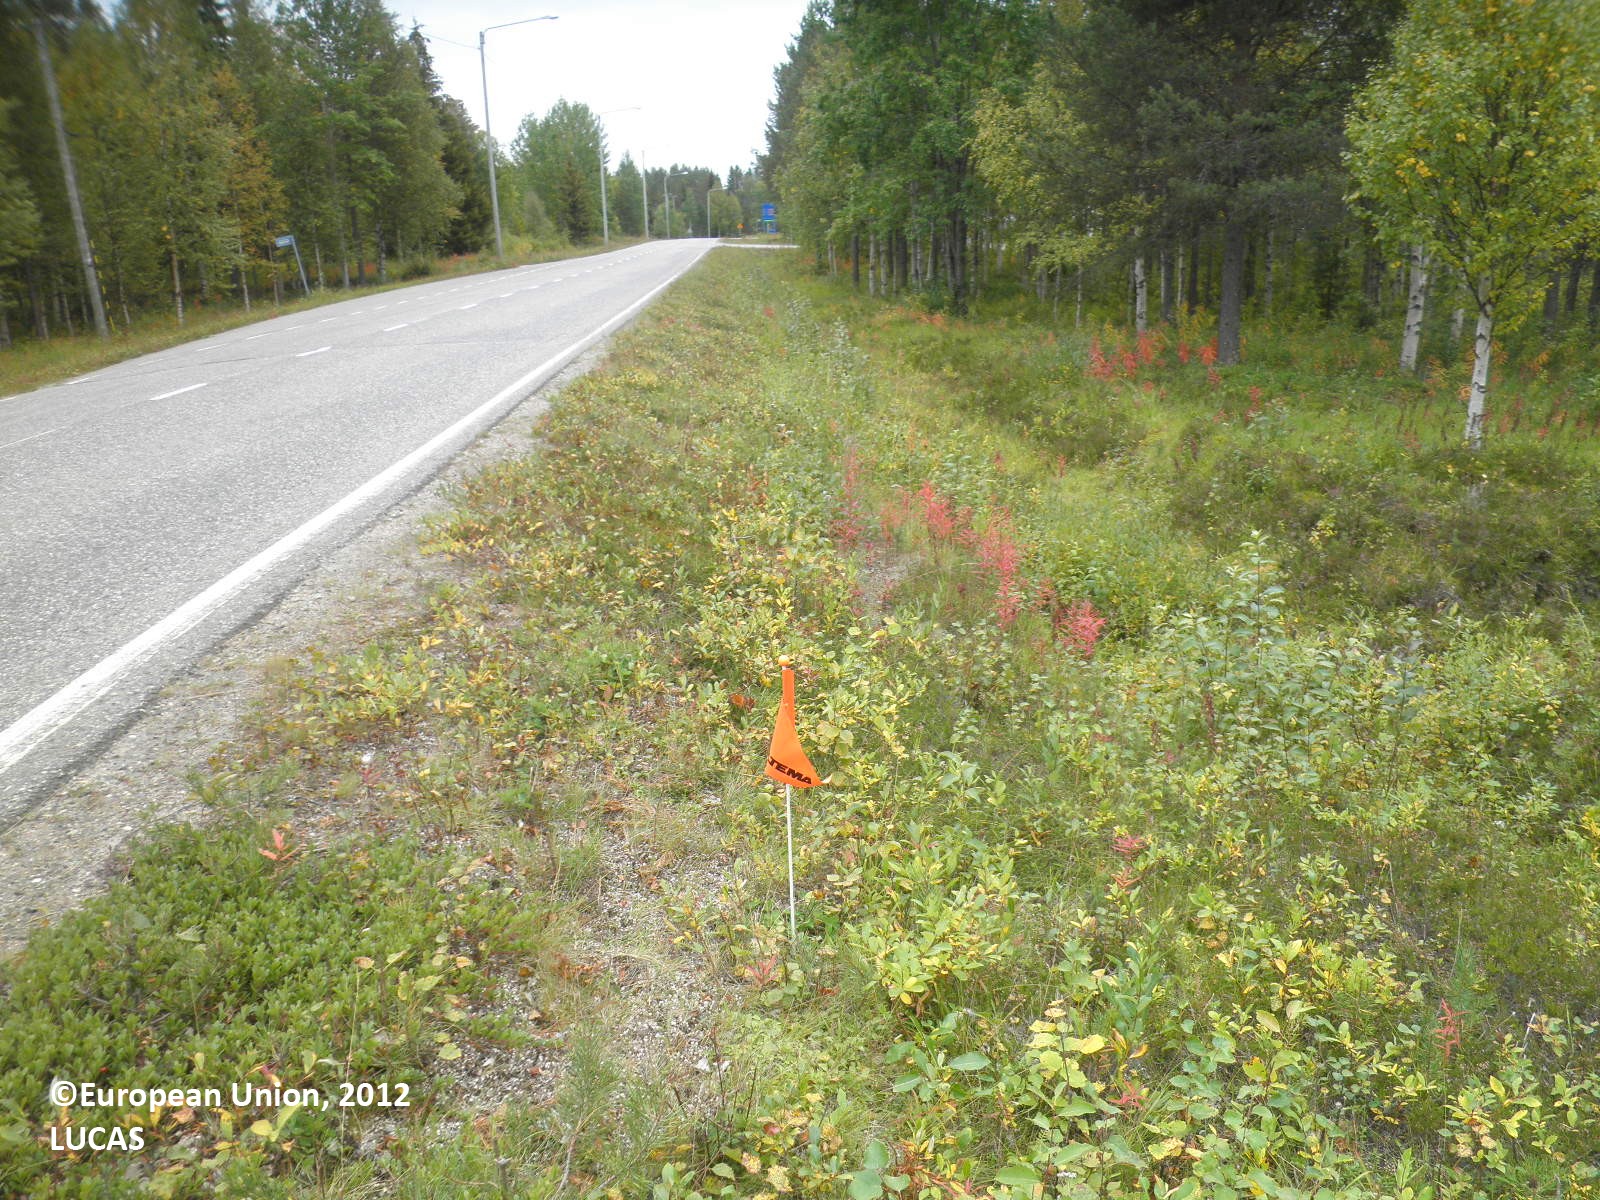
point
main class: Shrubland
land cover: Shrubland with sparse tree cover
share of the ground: > 75 %
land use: Road transport
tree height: < 5 m
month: August
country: FI
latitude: 67.2982
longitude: 28.1626
